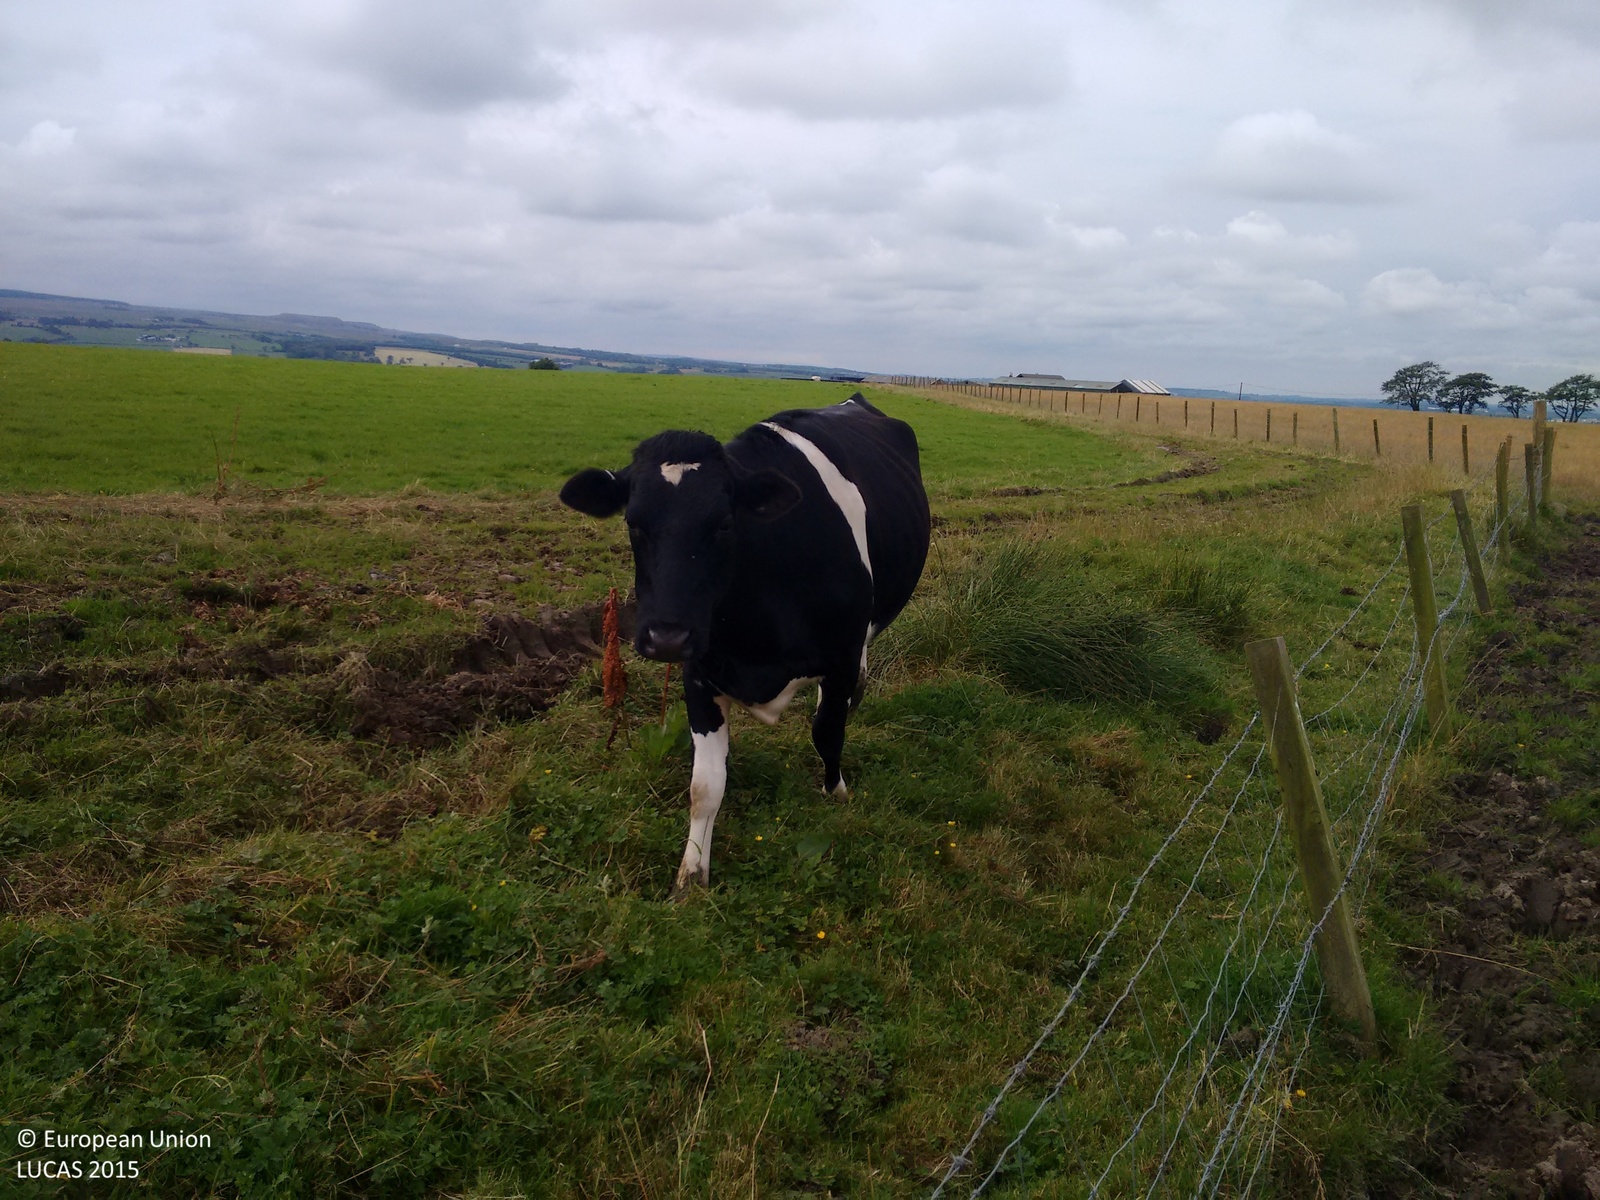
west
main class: Grassland
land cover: Grassland without tree/shrub cover
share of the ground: > 75 %
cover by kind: herbaceous plants 100 %
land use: Agriculture (excluding fallow land and kitchen gardens)
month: August
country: GB
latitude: 55.4460
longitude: -4.2113
